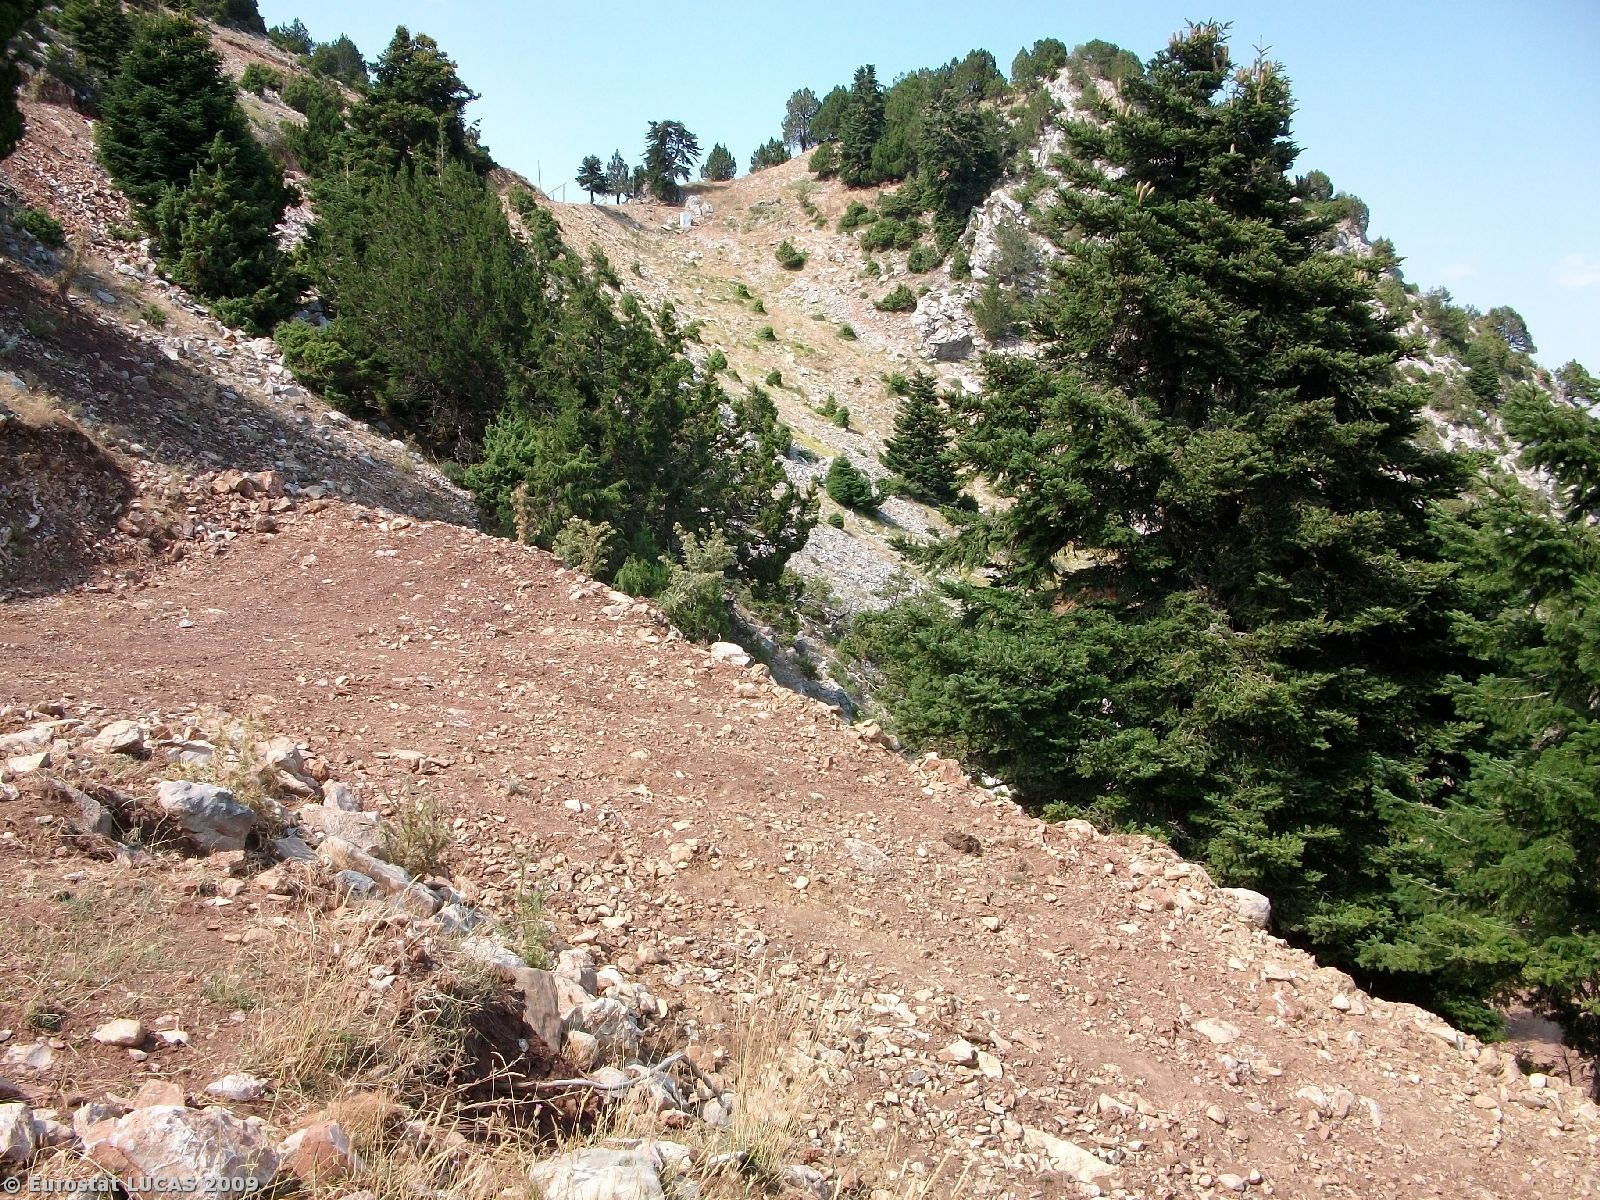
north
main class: Artificial land
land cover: Non built-up linear features
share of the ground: 50 - 75 %
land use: Water supply and treatment
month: August
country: GR
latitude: 39.0690
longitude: 21.5689
